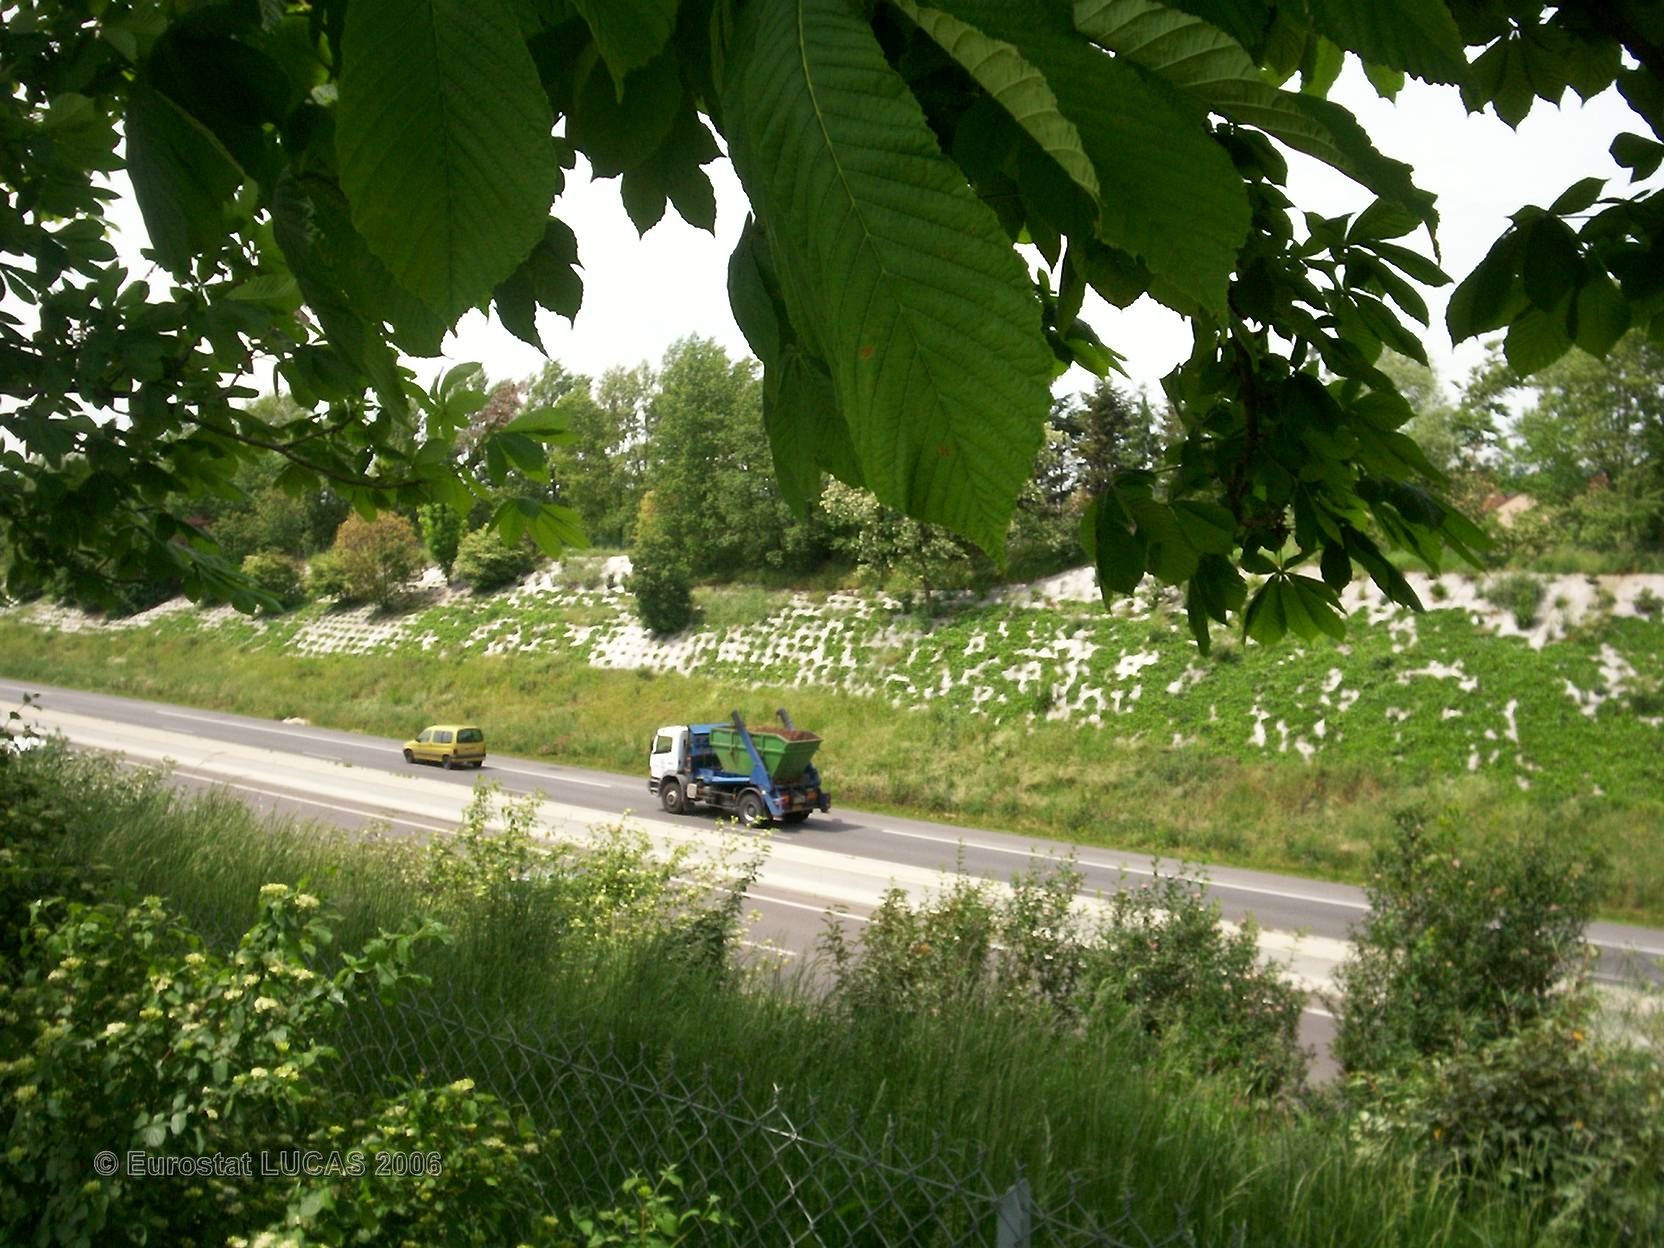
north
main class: Grassland
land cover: Grassland with sparse tree/shrub cover
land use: Unused
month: May
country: FR
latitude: 45.6834
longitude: 4.8038
